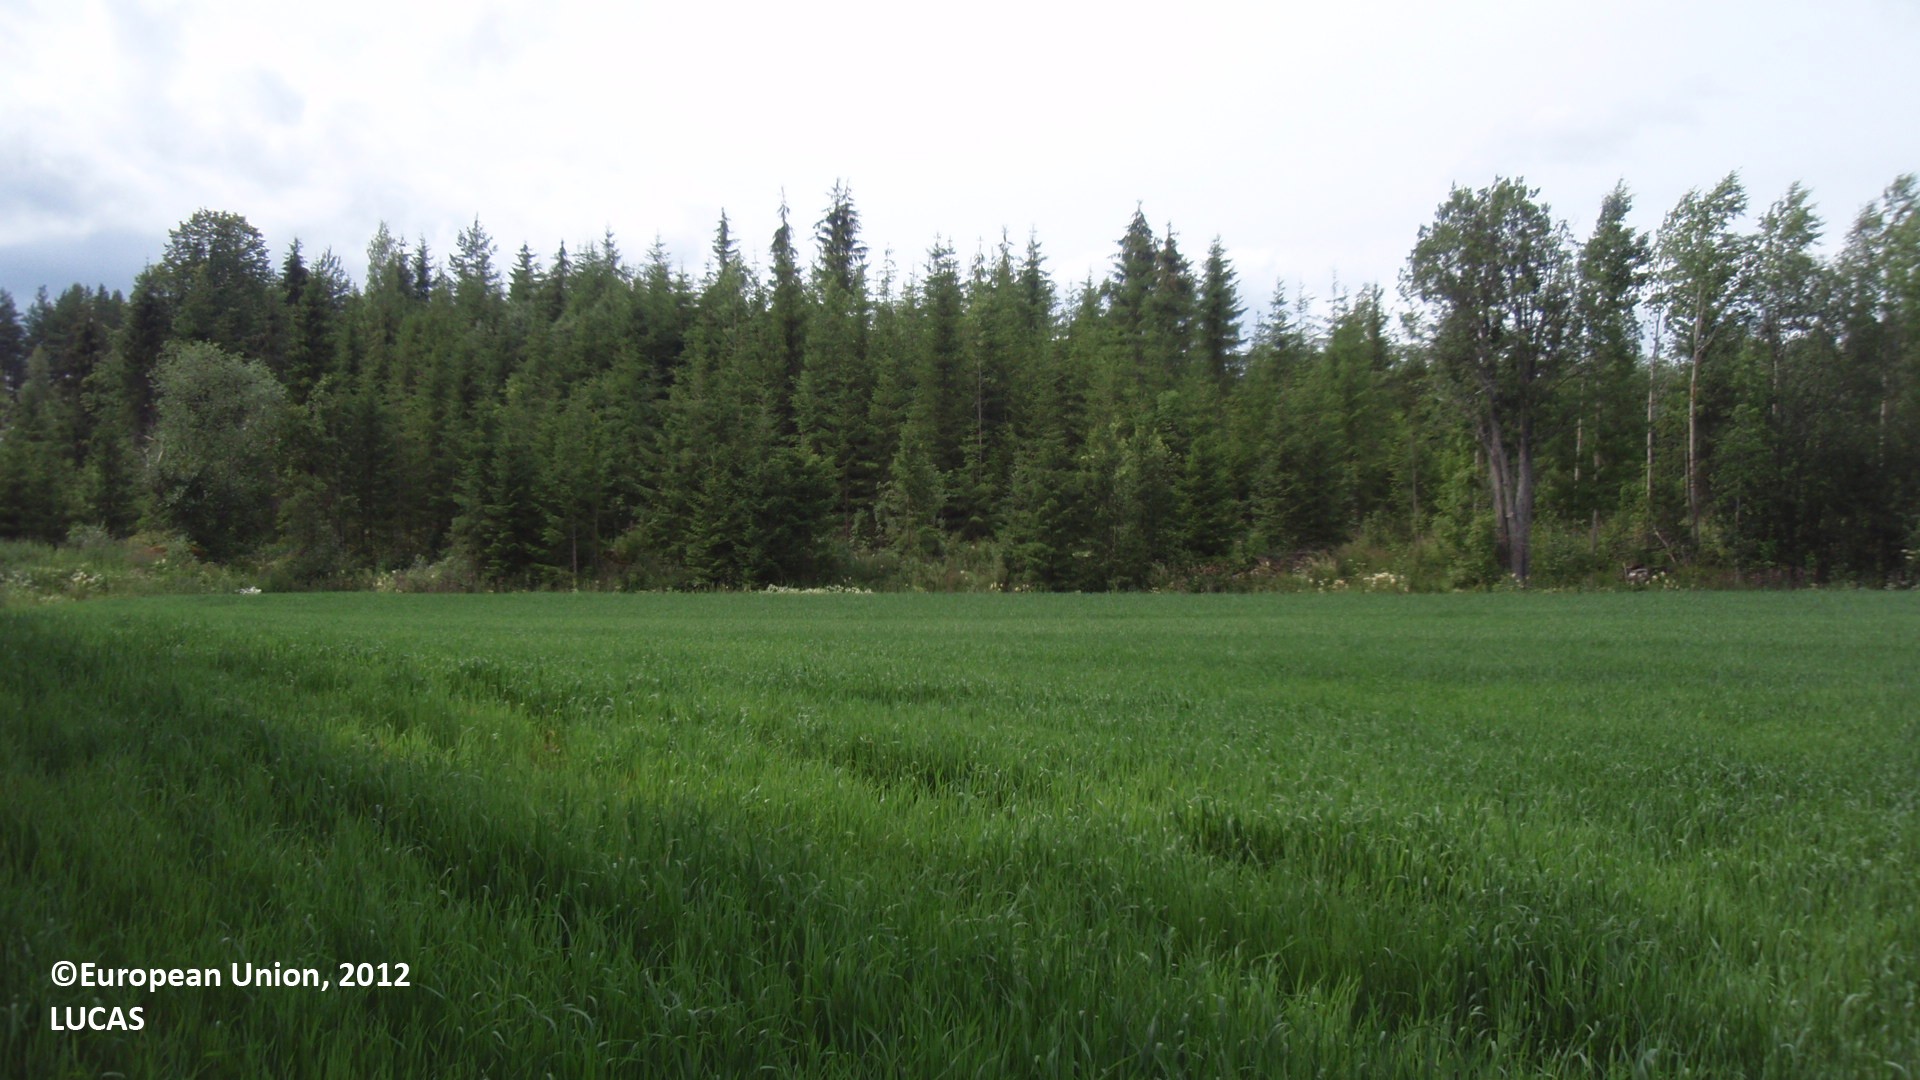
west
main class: Cropland
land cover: Oats
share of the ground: > 75 %
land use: Agriculture (excluding fallow land and kitchen gardens)
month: July
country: FI
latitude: 61.3169
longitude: 28.6537
